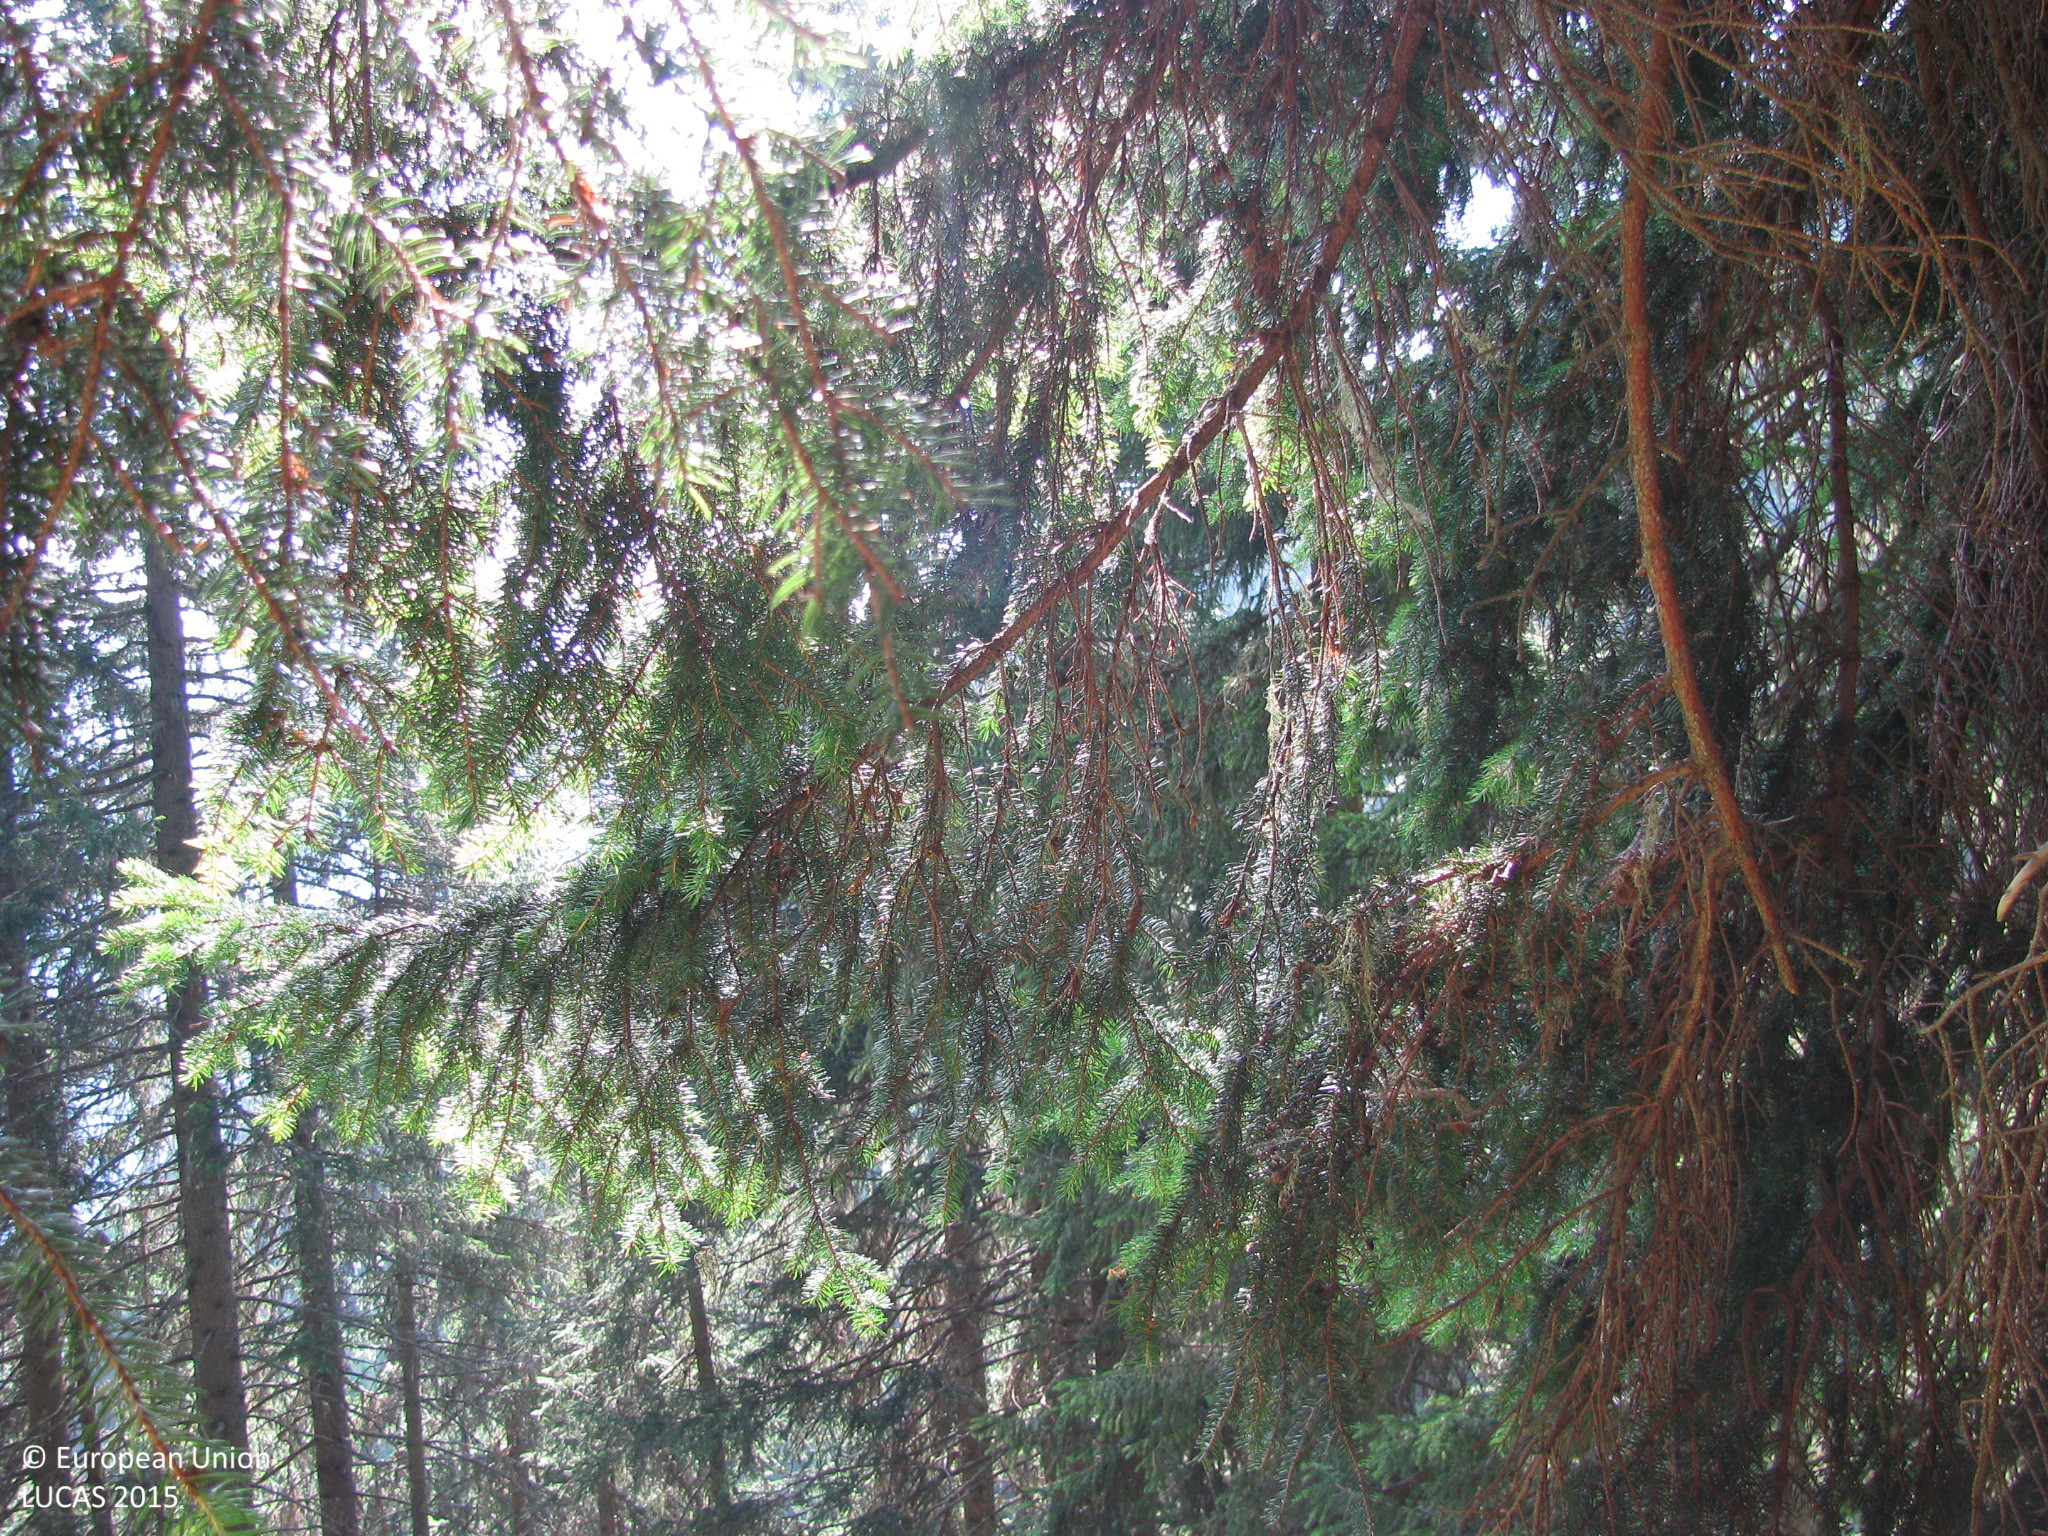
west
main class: Woodland
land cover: Spruce dominated coniferous woodland
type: alpine coniferous forest
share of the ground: > 75 %
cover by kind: coniferous forest trees 85 %, herbaceous plants 10 %, unconsolidated bare surface 5 %
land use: Forestry
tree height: > 5 m
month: July
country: AT
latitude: 46.7160
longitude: 12.6008
